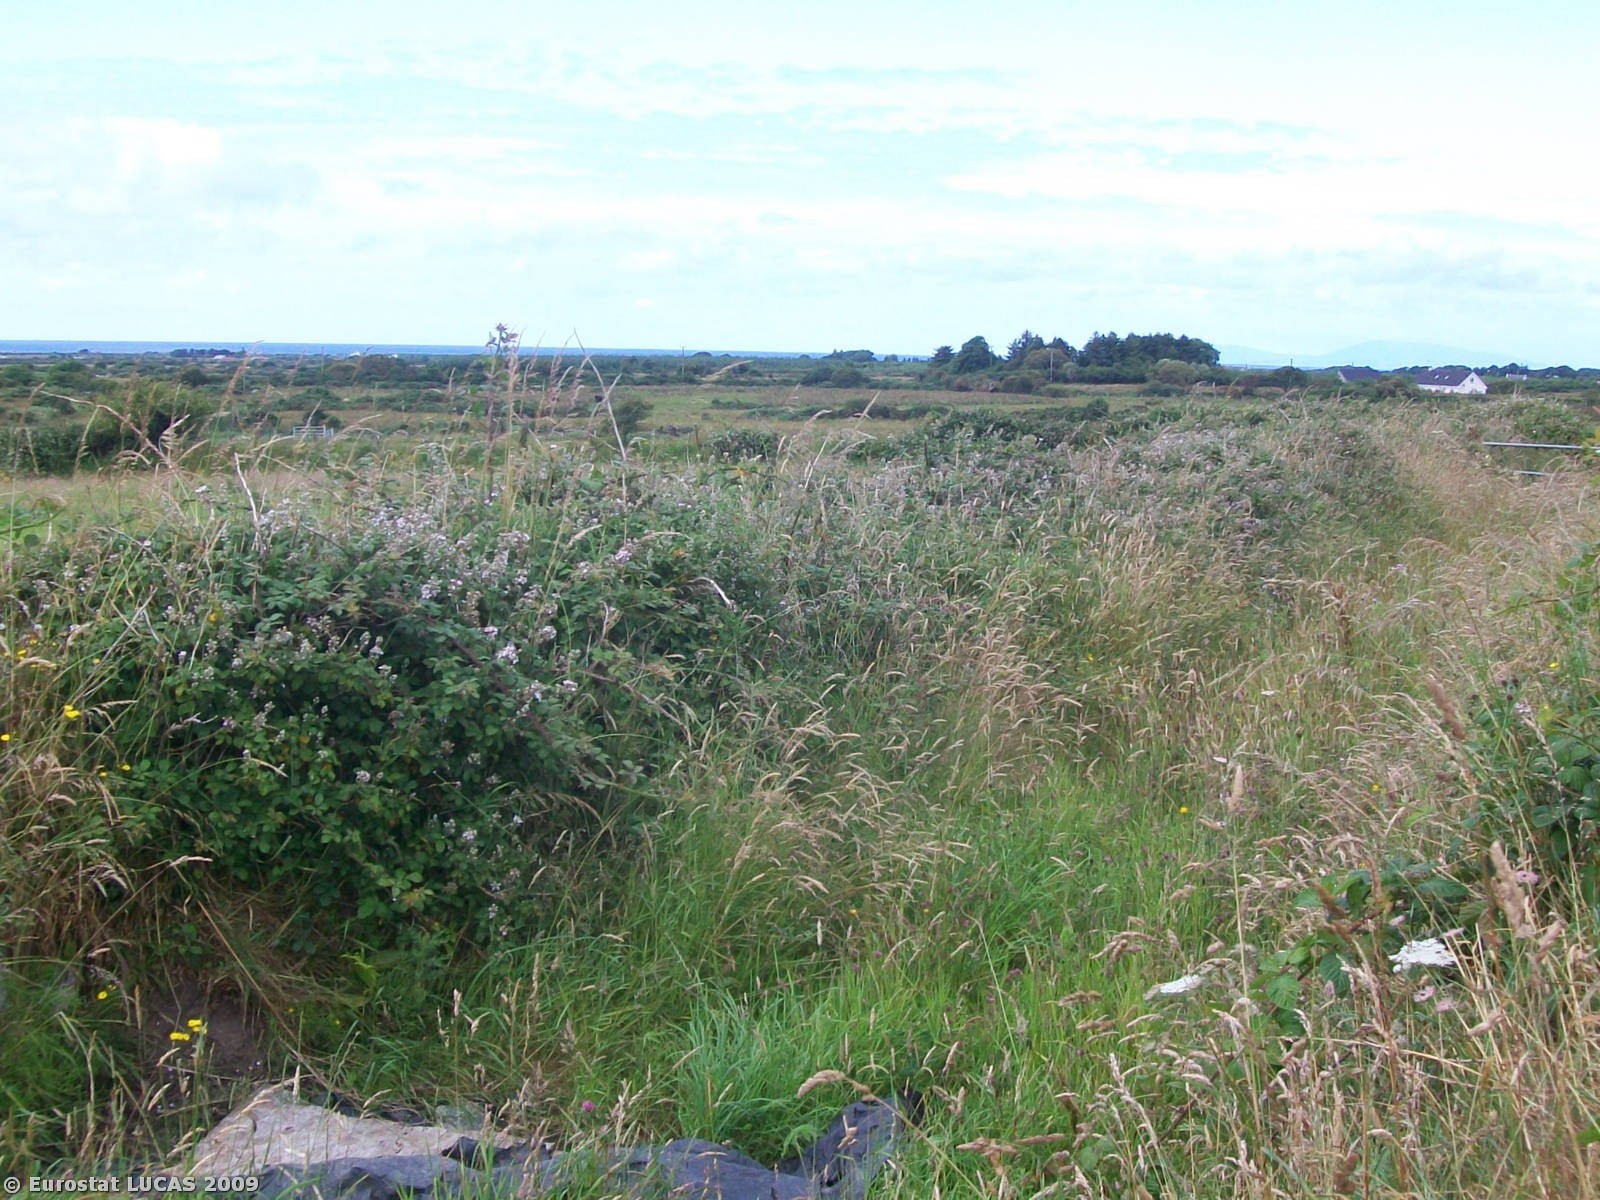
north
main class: Grassland
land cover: Grassland without tree/shrub cover
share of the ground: > 75 %
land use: Agriculture (excluding fallow land and kitchen gardens)
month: July
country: IE
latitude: 54.2495
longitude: -8.9804
